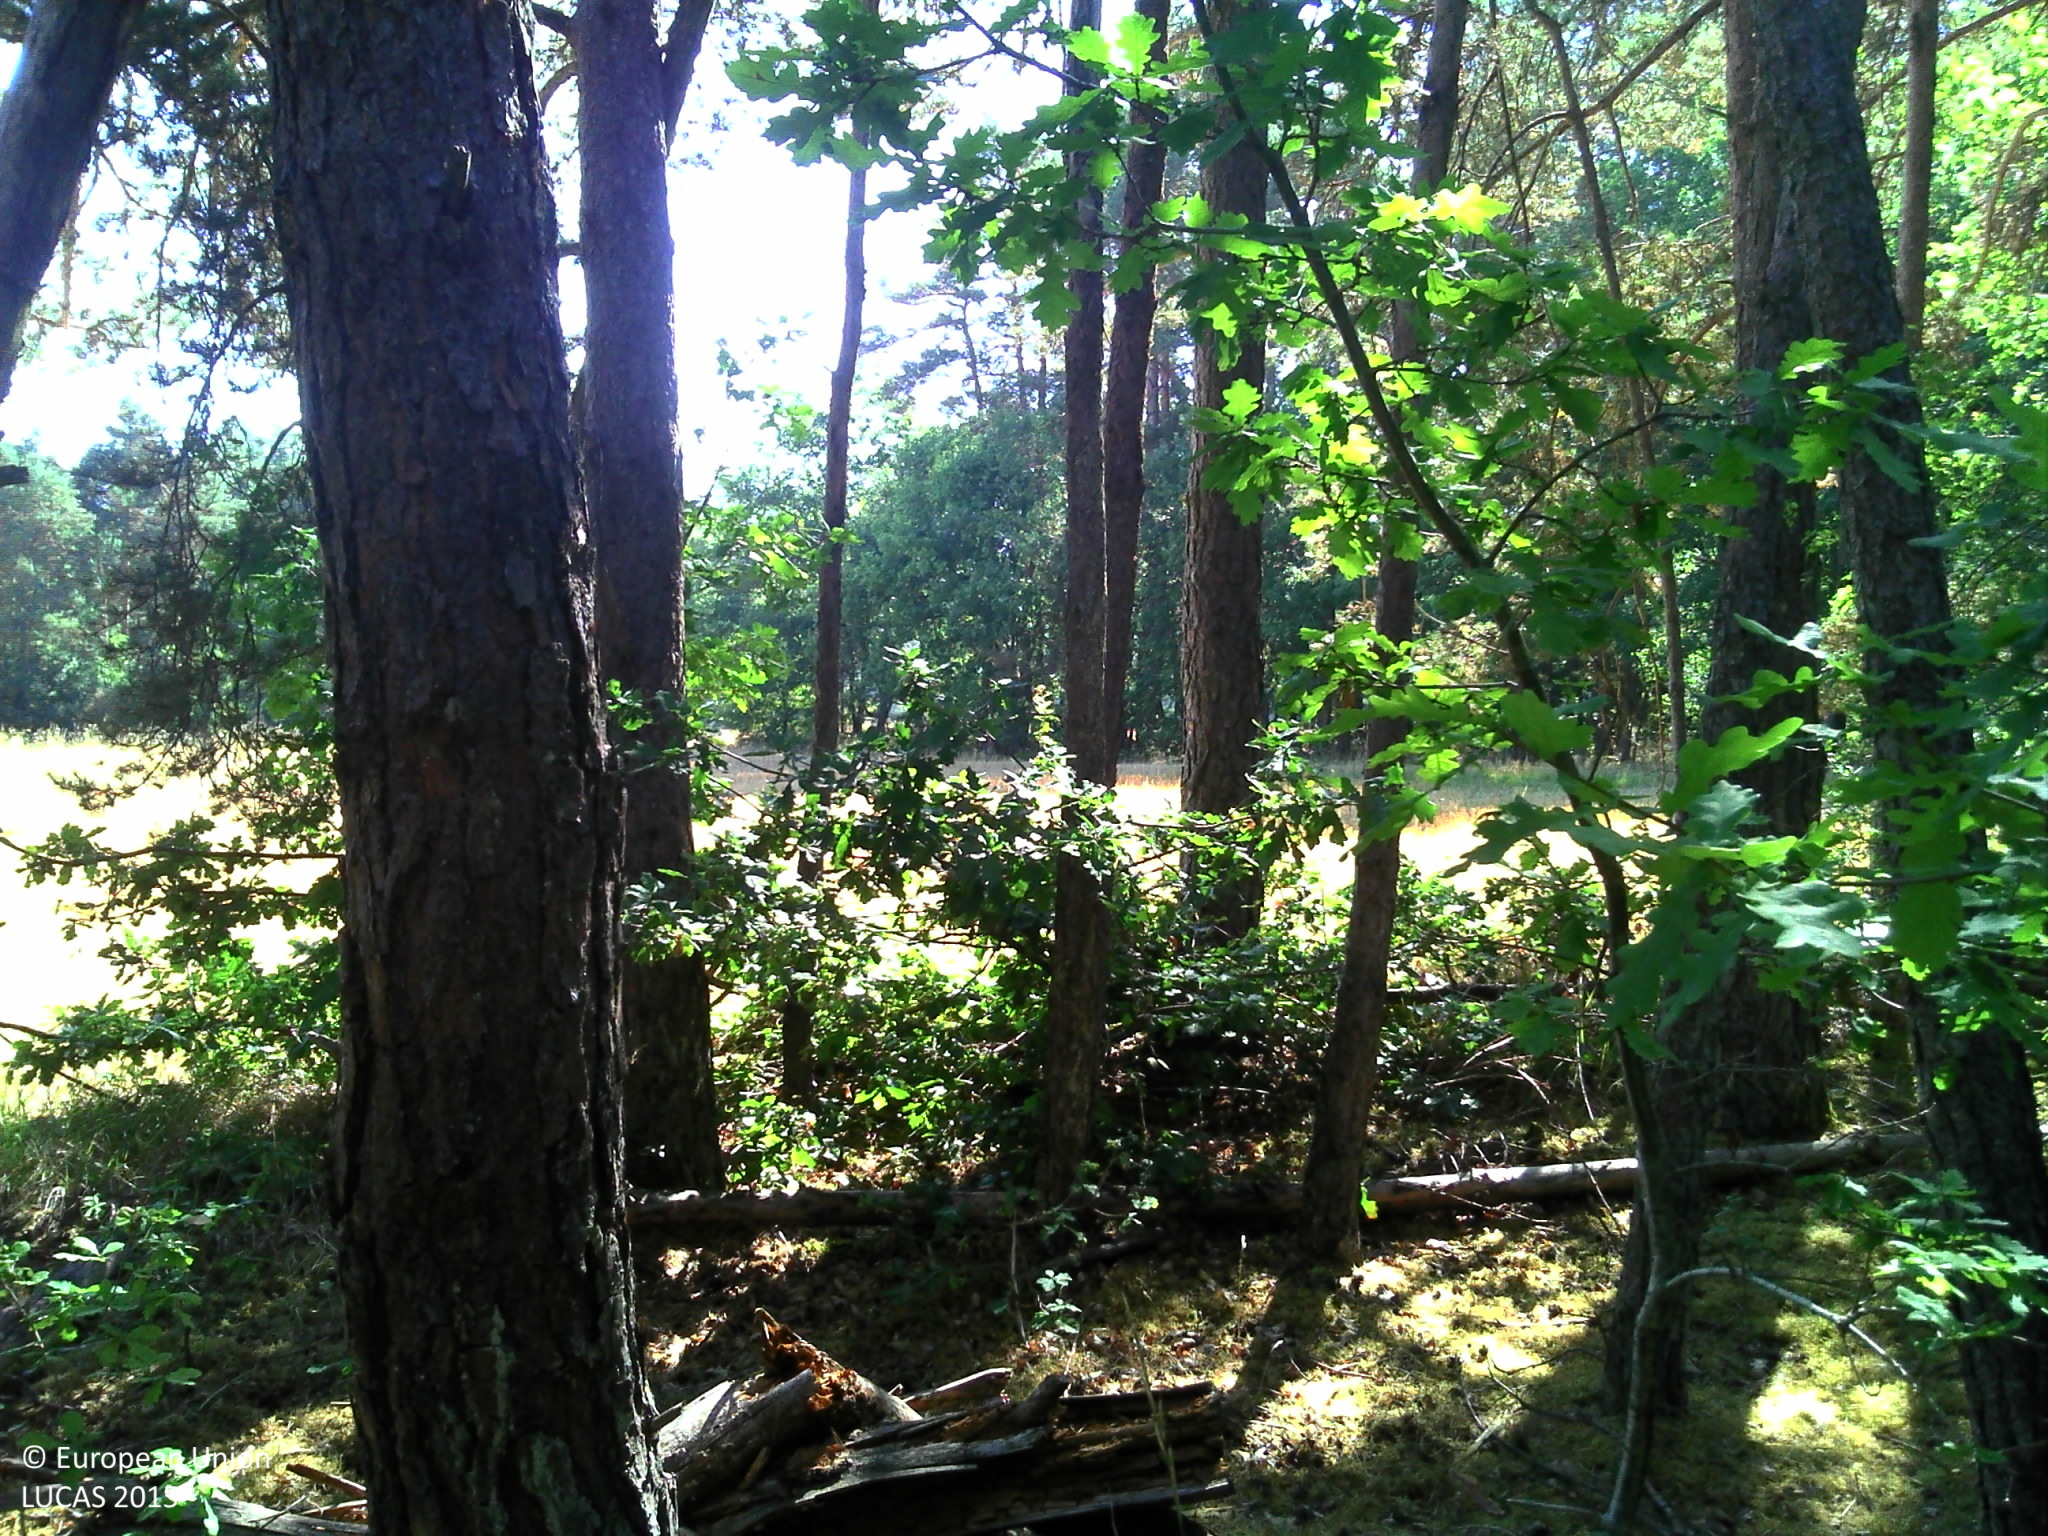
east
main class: Woodland
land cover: Pine dominated mixed woodland
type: acidophilous oak and oak-birch forest
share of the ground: > 75 %
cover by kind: coniferous forest trees 75 %, broadleaved forest trees 25 %
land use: Forestry
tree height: > 5 m
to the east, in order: Pine dominated mixed woodland; Grass margins; Durum wheat; Grass margins; Pine dominated mixed woodland; Grass margins; Common wheat; Grass margins; Tracks; Grass margins; Ditches and canals; Common wheat
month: July
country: FR
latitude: 45.2836
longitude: 3.4622
